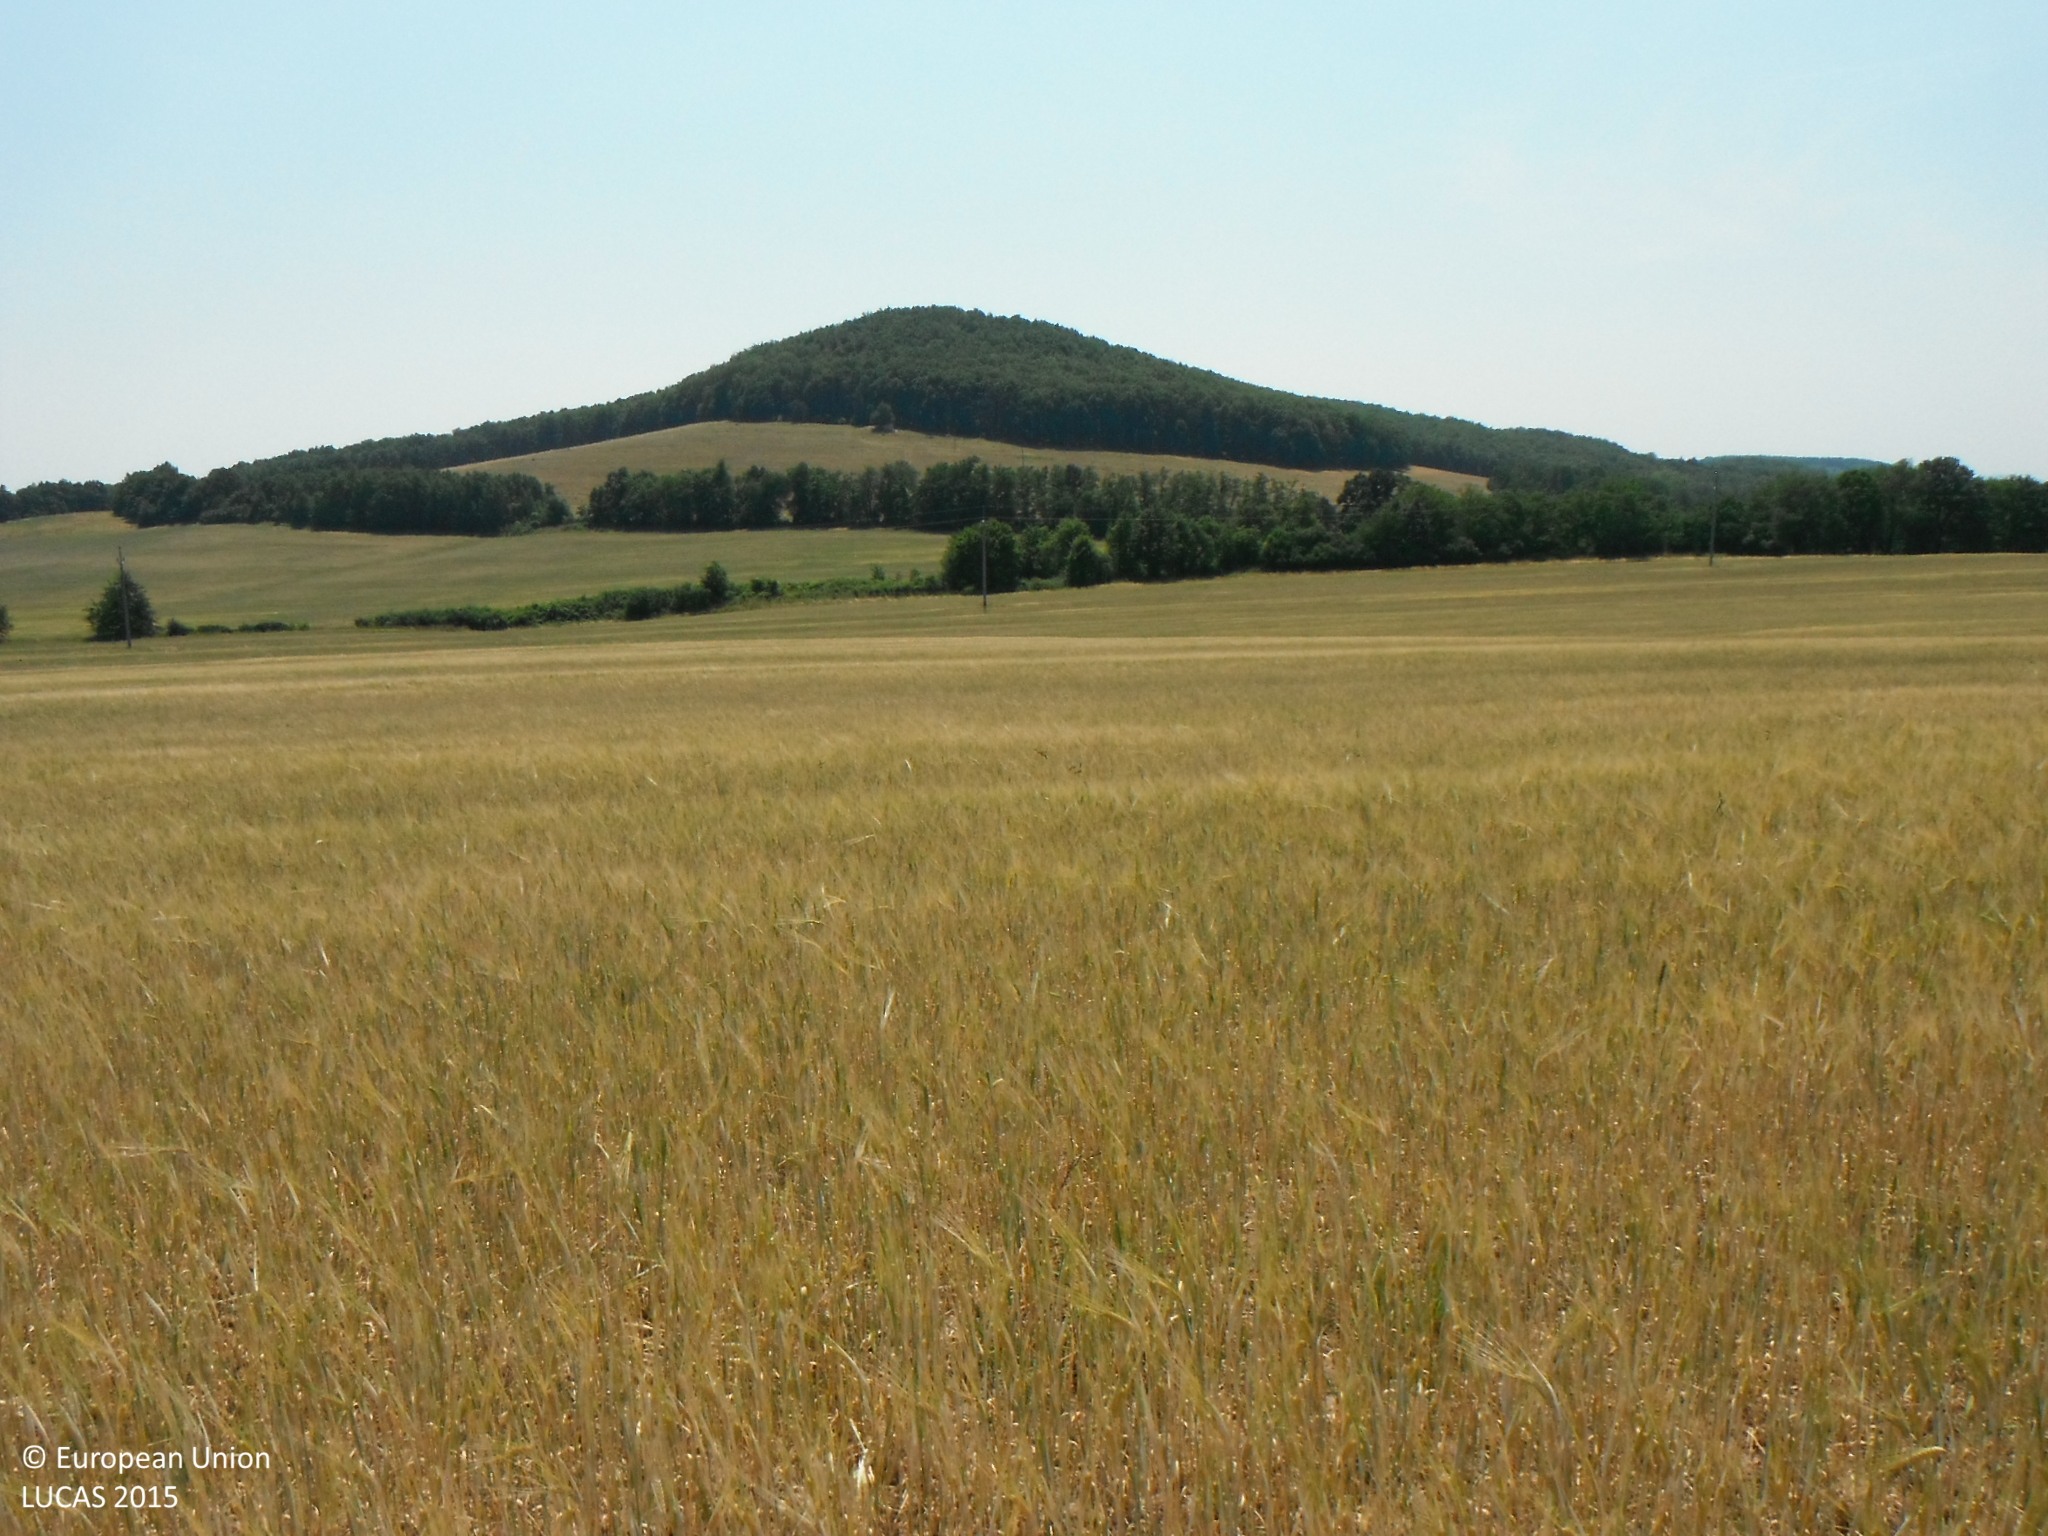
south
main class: Cropland
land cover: Barley
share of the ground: > 75 %
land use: Agriculture (excluding fallow land and kitchen gardens)
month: July
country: SK
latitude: 48.1861
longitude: 19.1542
